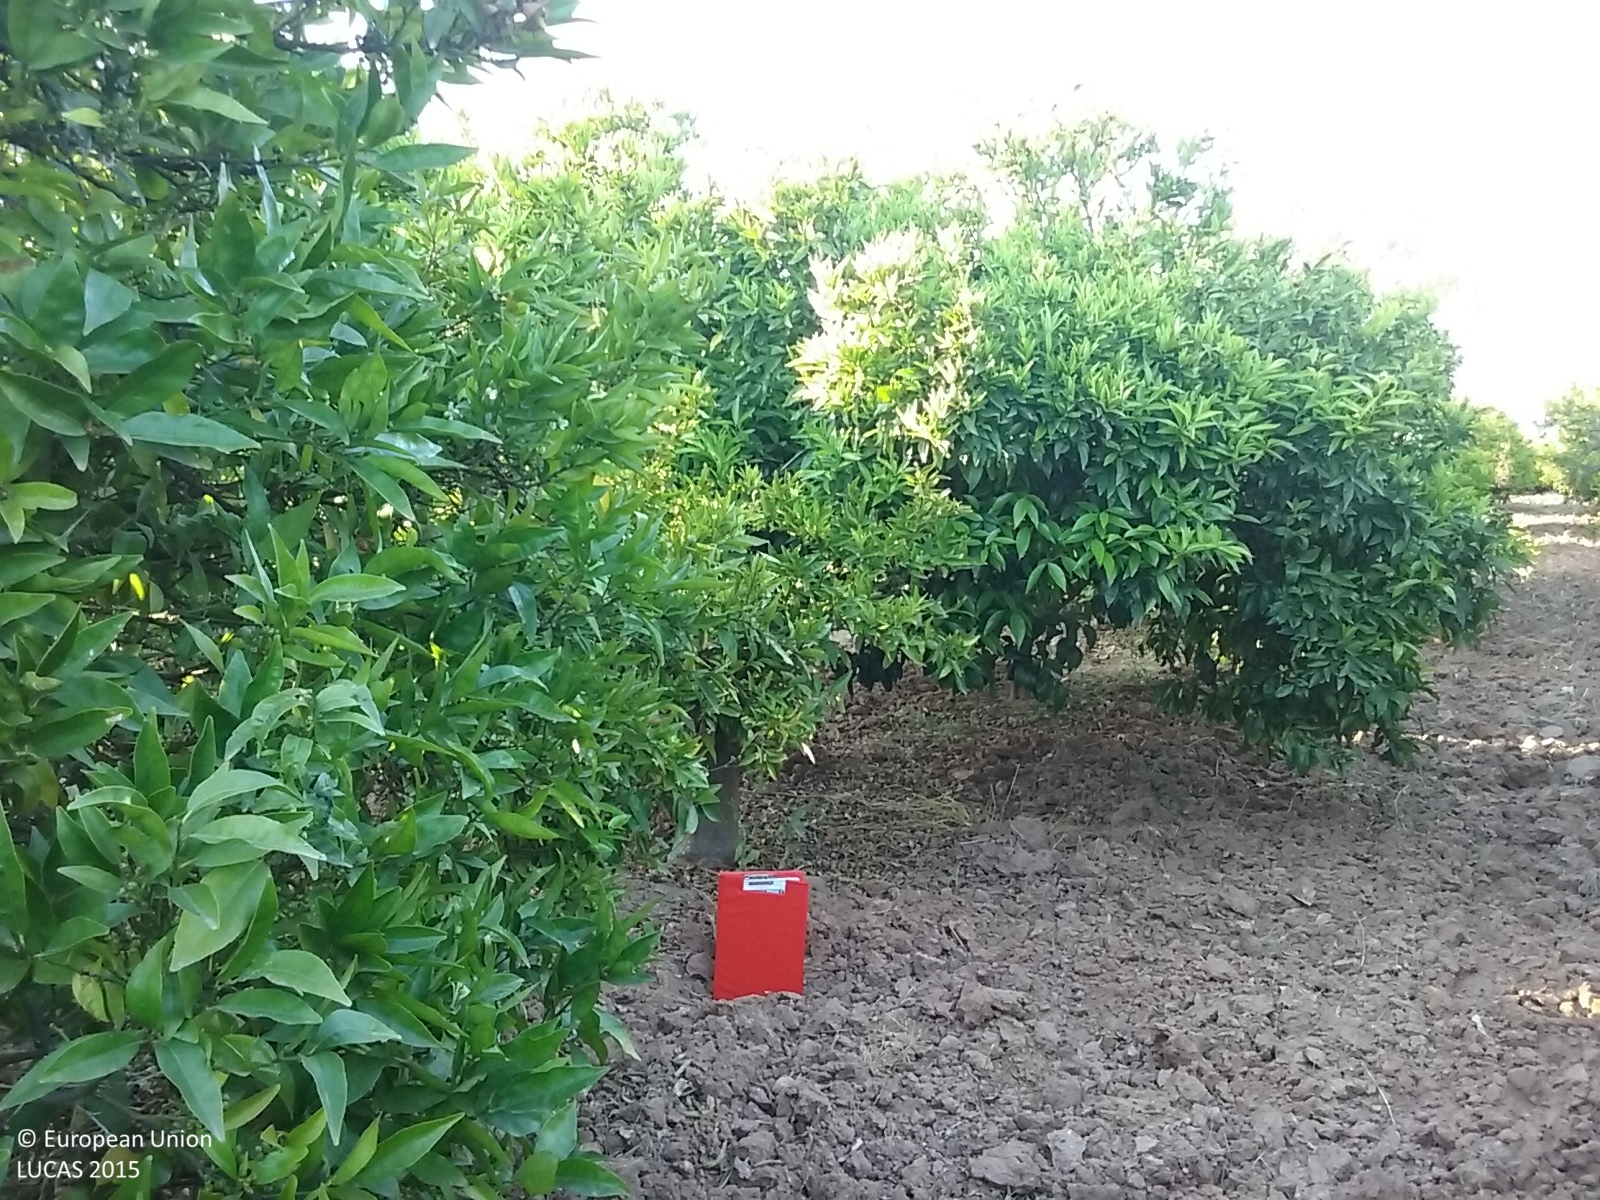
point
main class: Cropland
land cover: Other citrus fruit
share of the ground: 50 - 75 %
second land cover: Other bare soil
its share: > 75 %
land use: Agriculture (excluding fallow land and kitchen gardens)
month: May
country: ES
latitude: 39.9343
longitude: -0.0291
